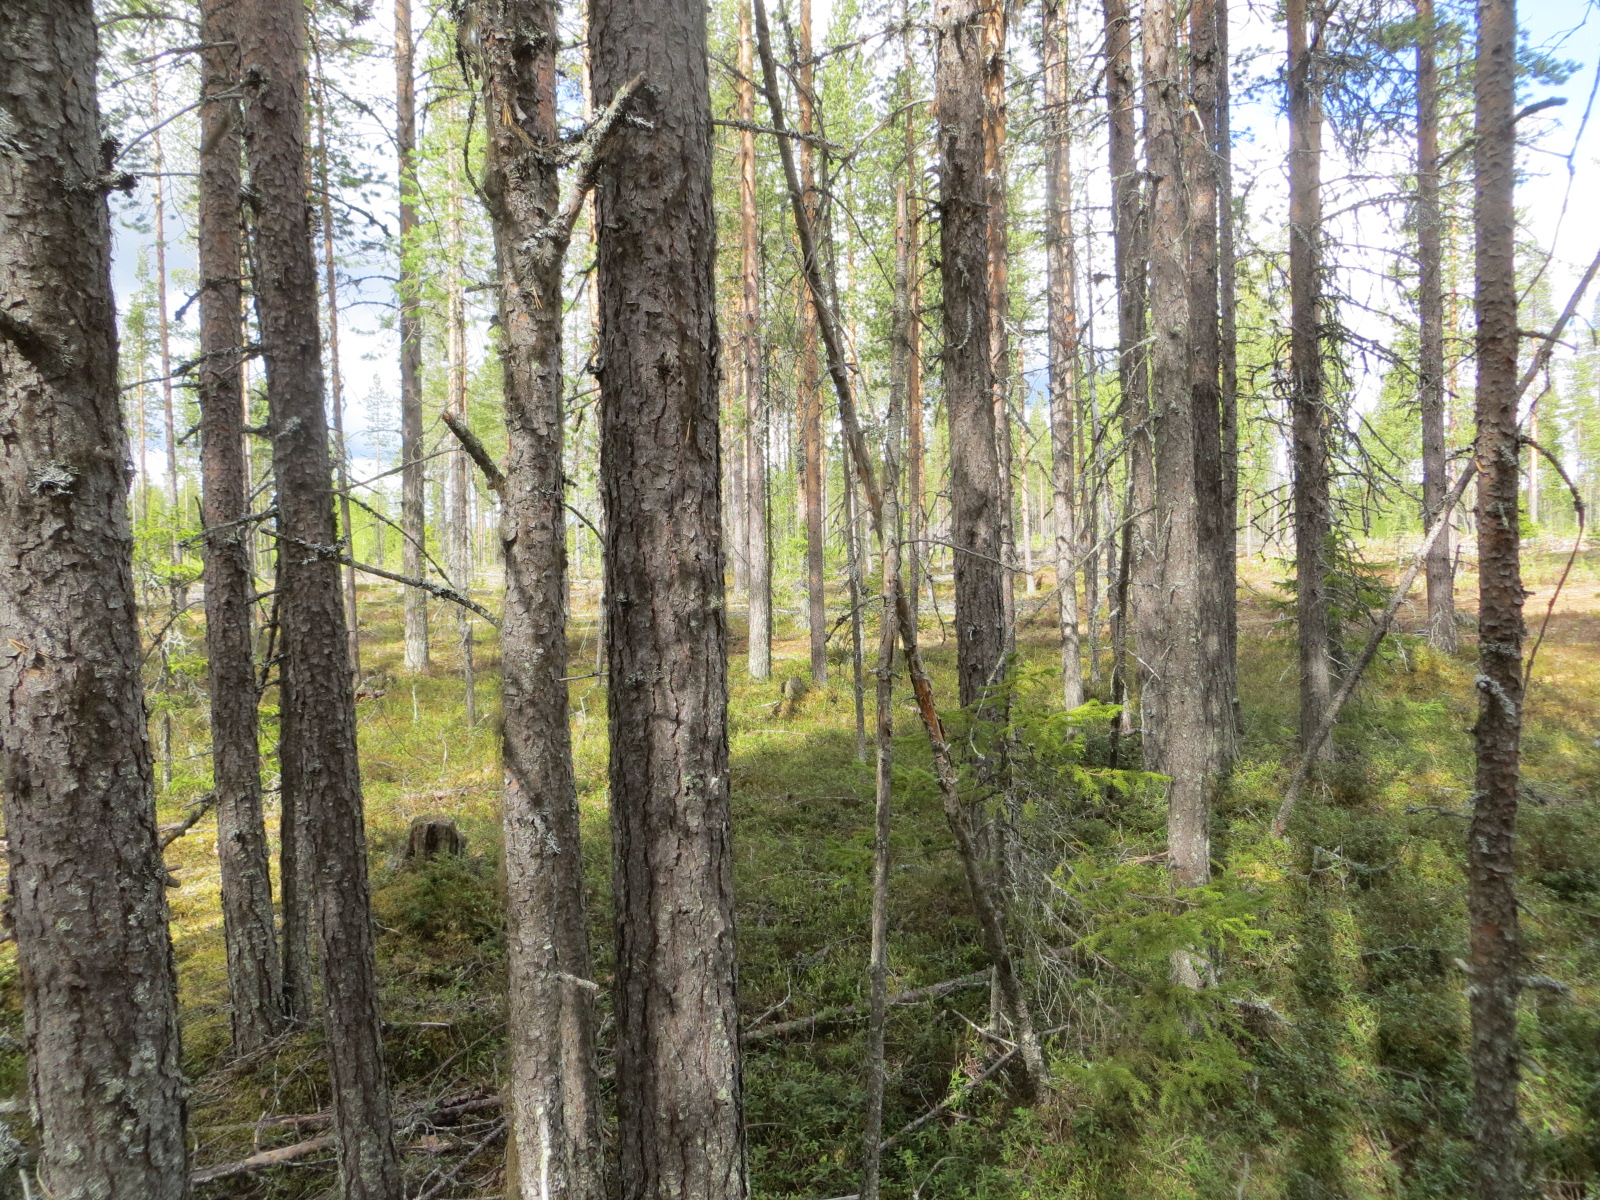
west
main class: Woodland
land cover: Pine dominated coniferous woodland
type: boreal forest
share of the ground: > 75 %
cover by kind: coniferous forest trees 90 %, shrubs 10 %
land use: Forestry
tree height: > 5 m
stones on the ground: < 10 %
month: June
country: FI
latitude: 67.5407
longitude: 25.8898
